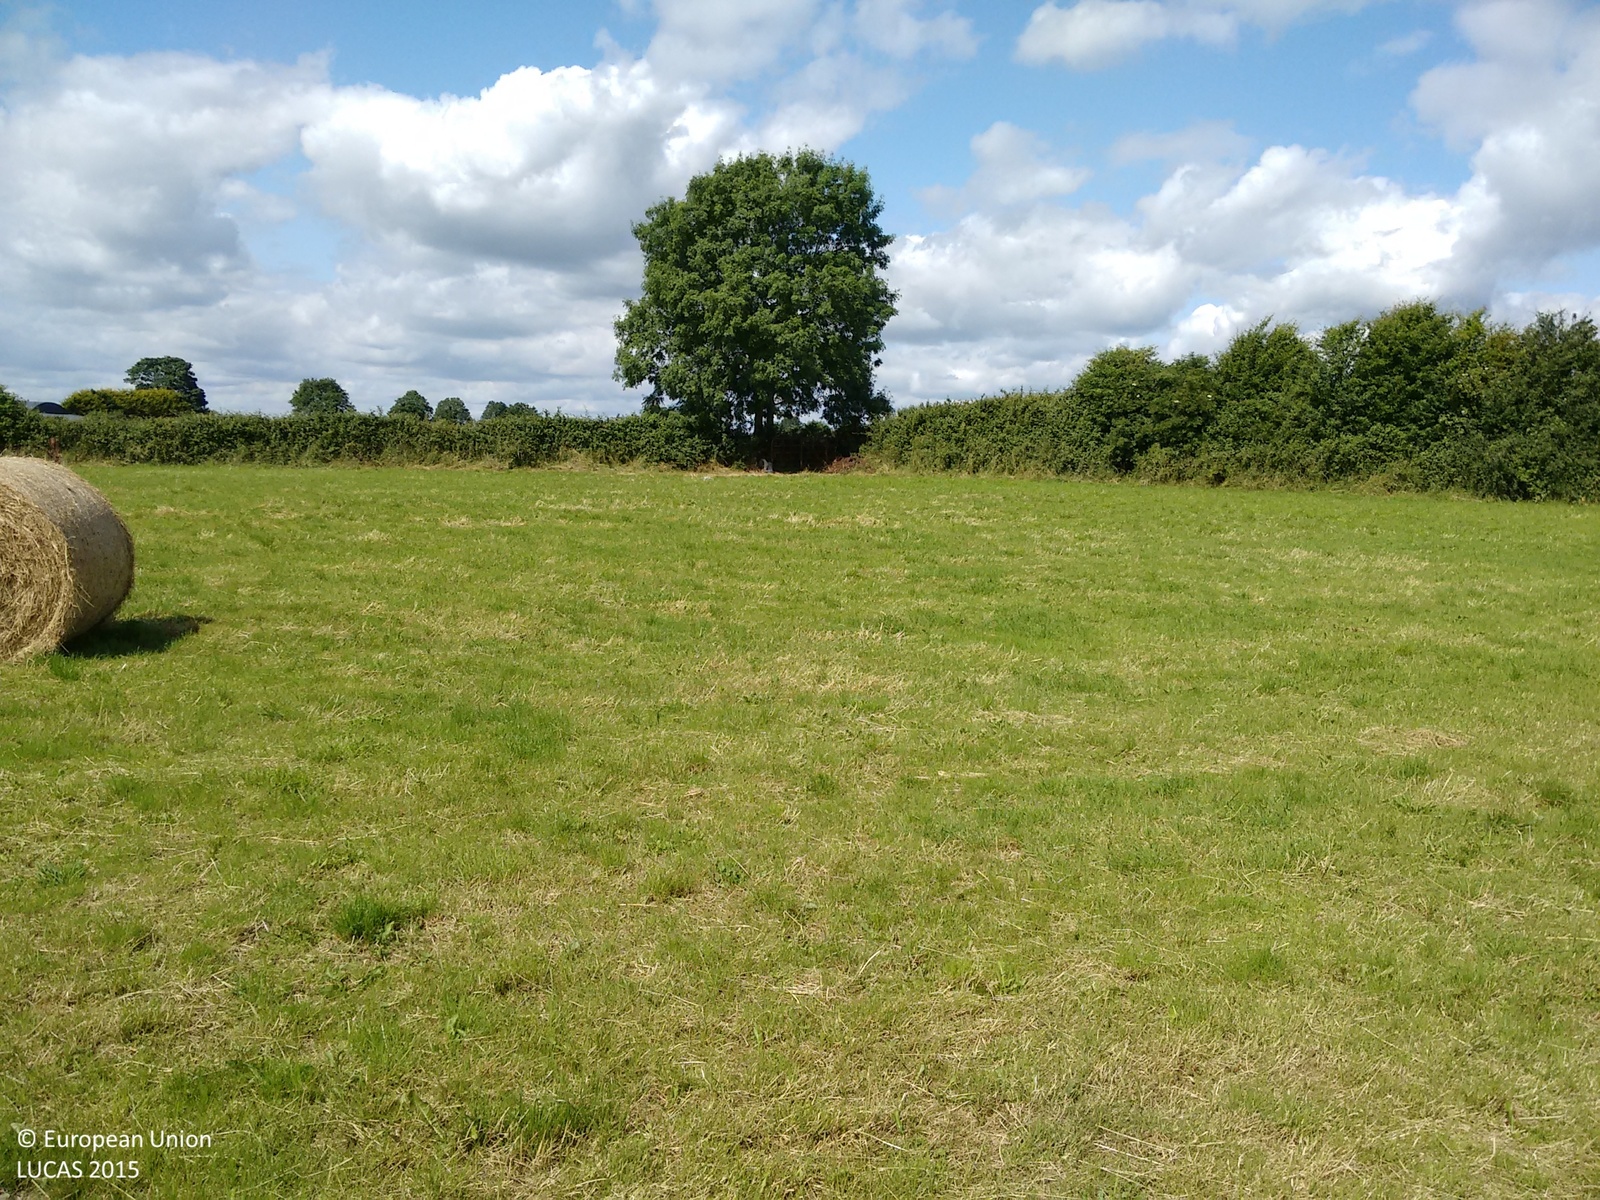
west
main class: Grassland
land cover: Grassland without tree/shrub cover
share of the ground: > 75 %
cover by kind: herbaceous plants 100 %
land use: Agriculture (excluding fallow land and kitchen gardens)
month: July
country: IE
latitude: 53.5585
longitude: -7.9413
